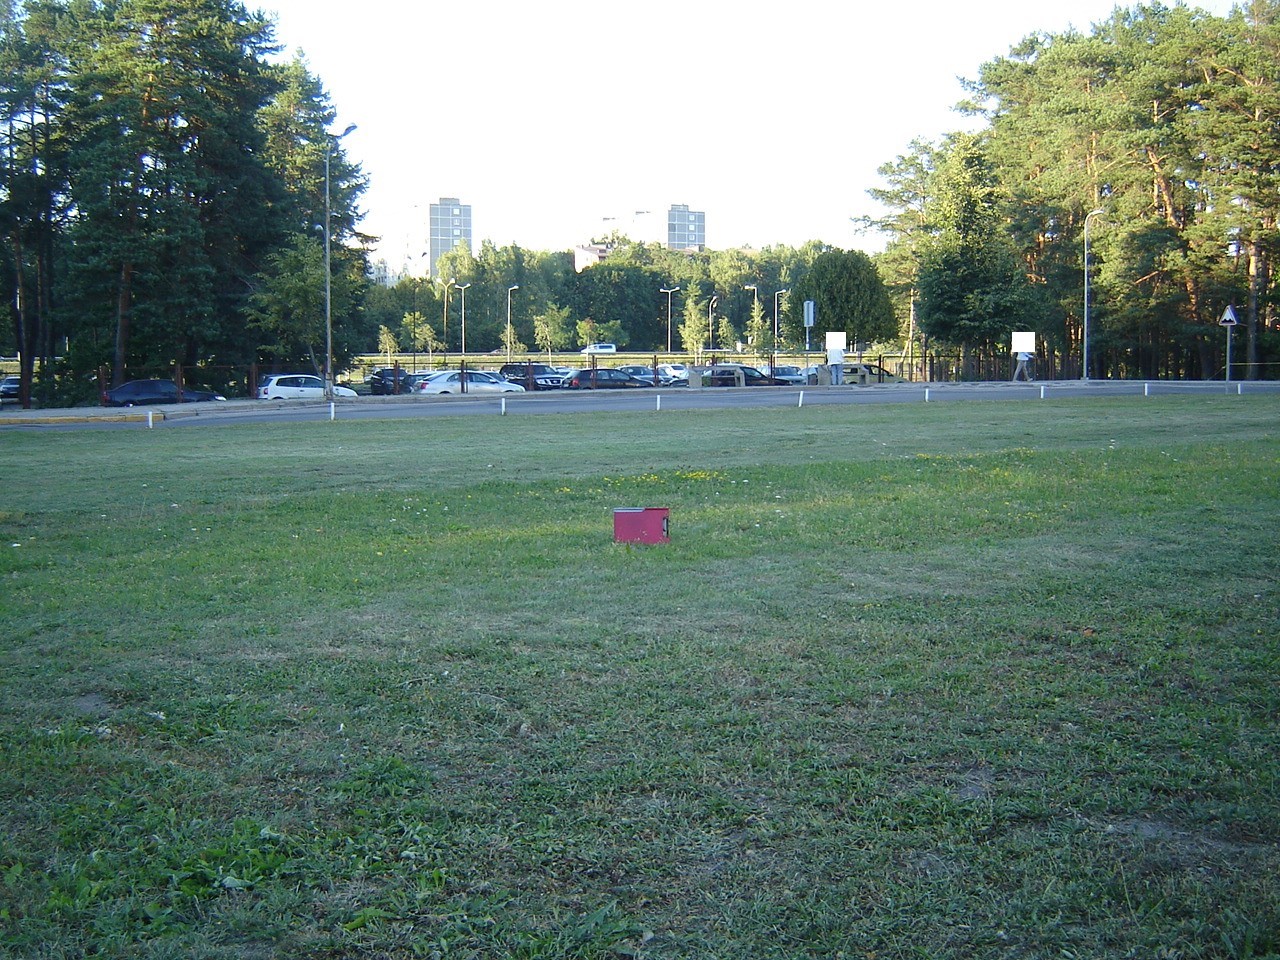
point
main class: Grassland
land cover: Grassland without tree/shrub cover
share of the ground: > 75 %
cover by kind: herbaceous plants 100 %
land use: Community services
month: August
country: LT
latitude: 54.6688
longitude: 25.2062
